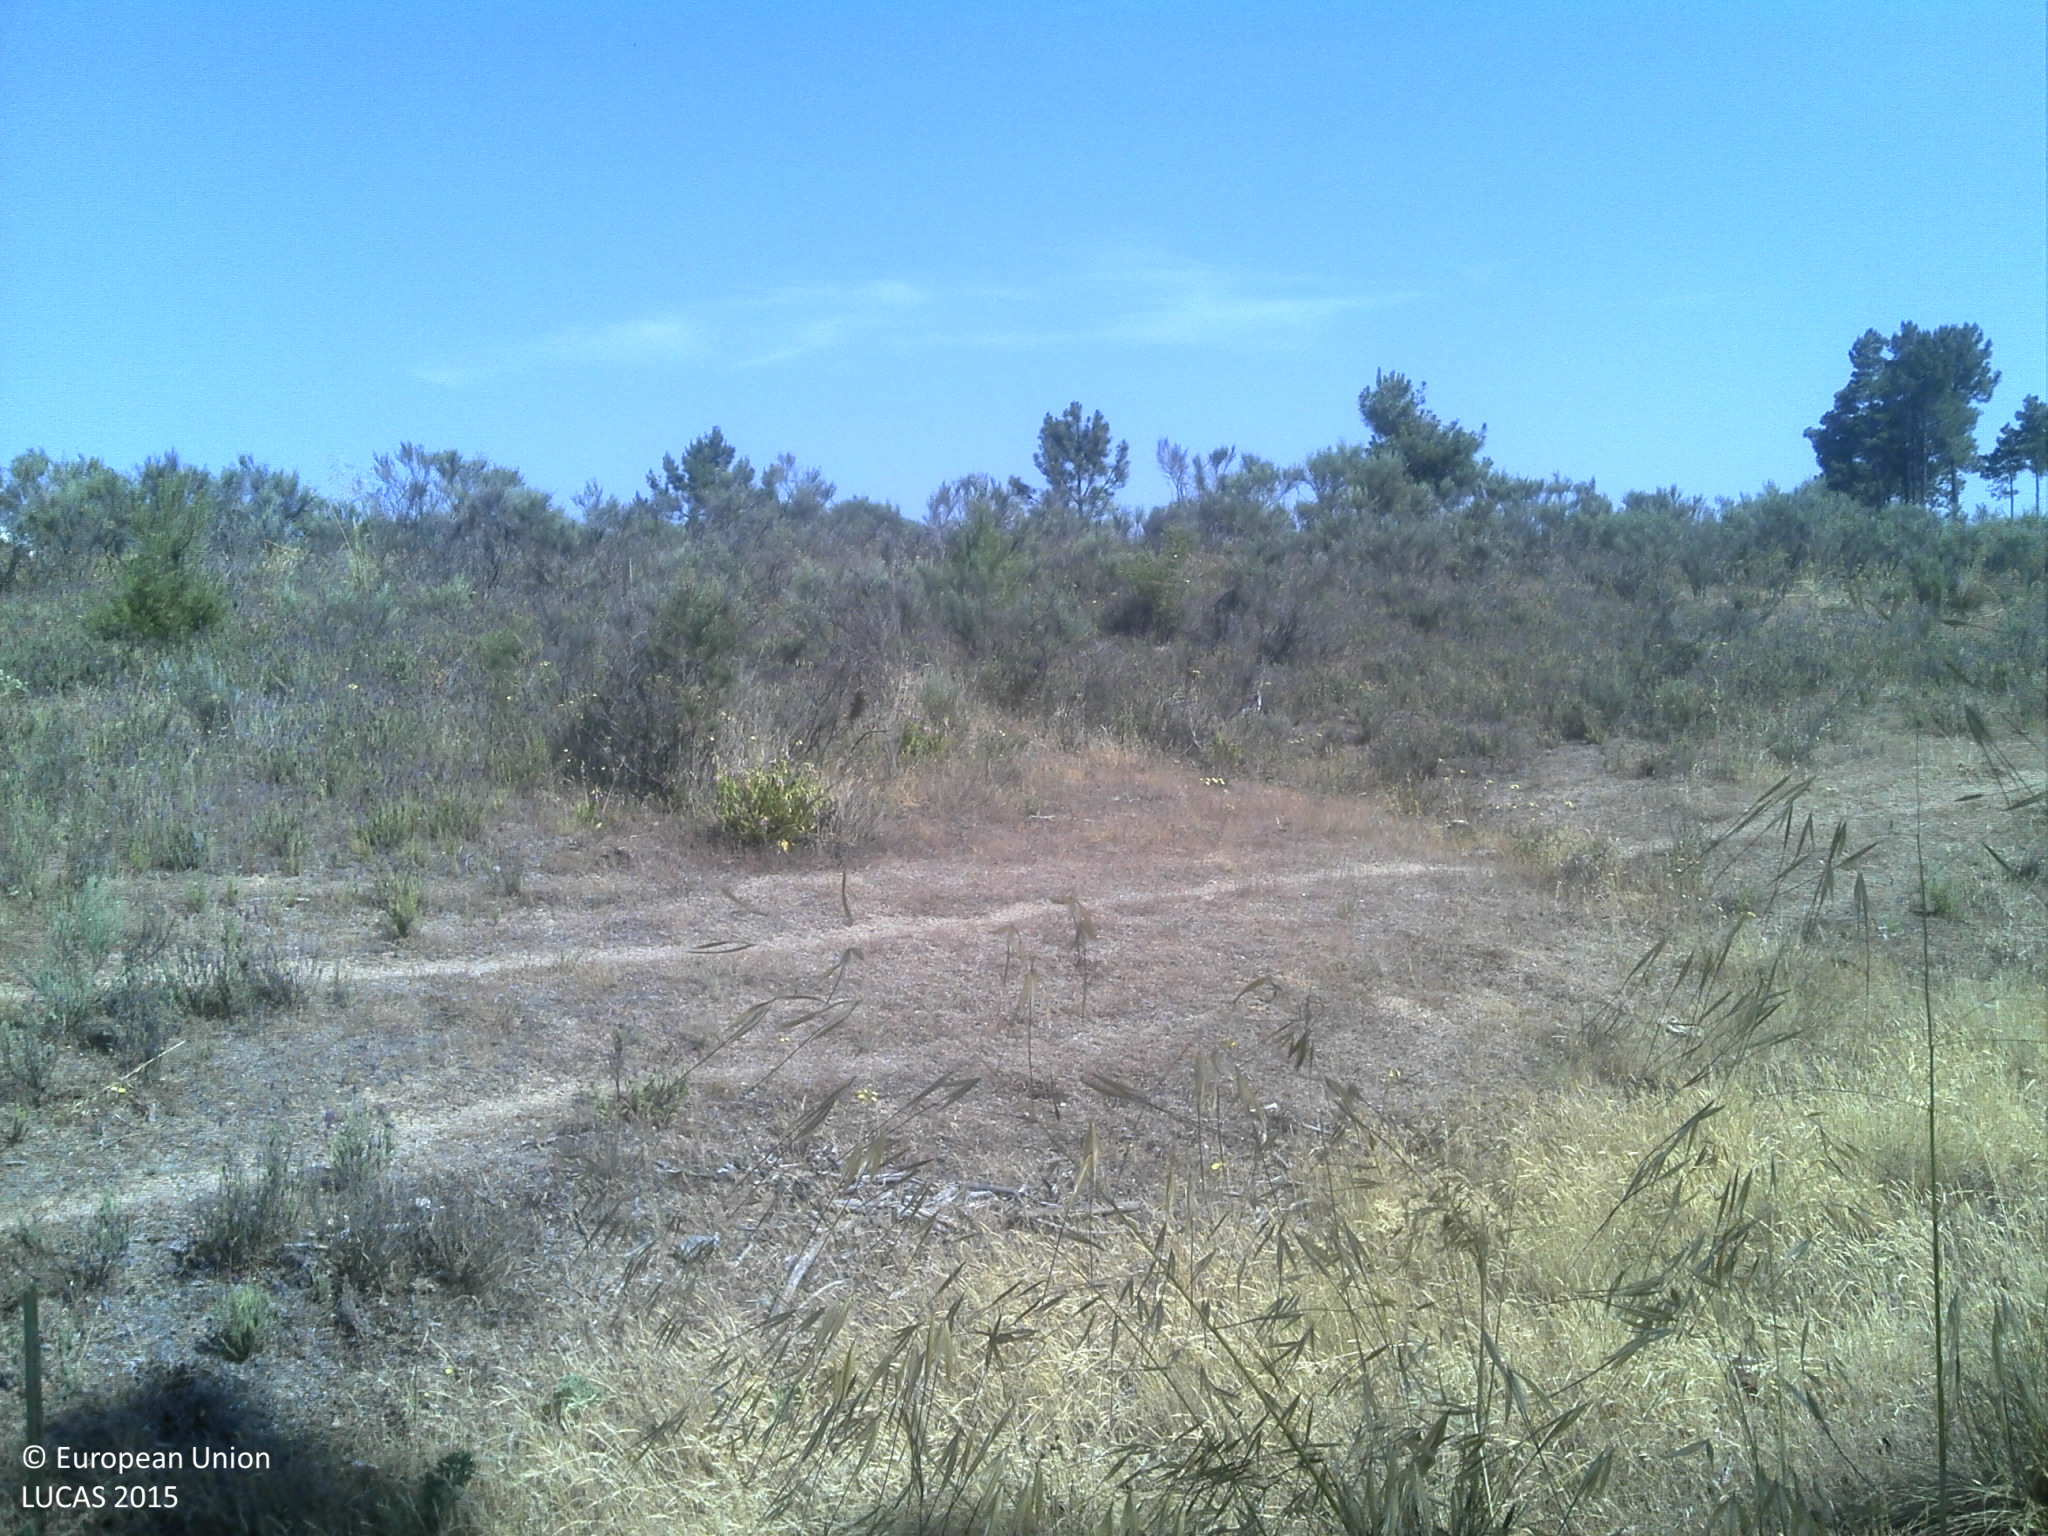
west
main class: Shrubland
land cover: Shrubland with sparse tree cover
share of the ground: 50 - 75 %
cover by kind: shrubs 70 %, unconsolidated bare surface 15 %, herbaceous plants 10 %, broadleaved forest trees 5 %
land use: Semi-natural and natural areas not in use
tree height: < 5 m
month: June
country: PT
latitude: 40.4365
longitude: -6.9666
